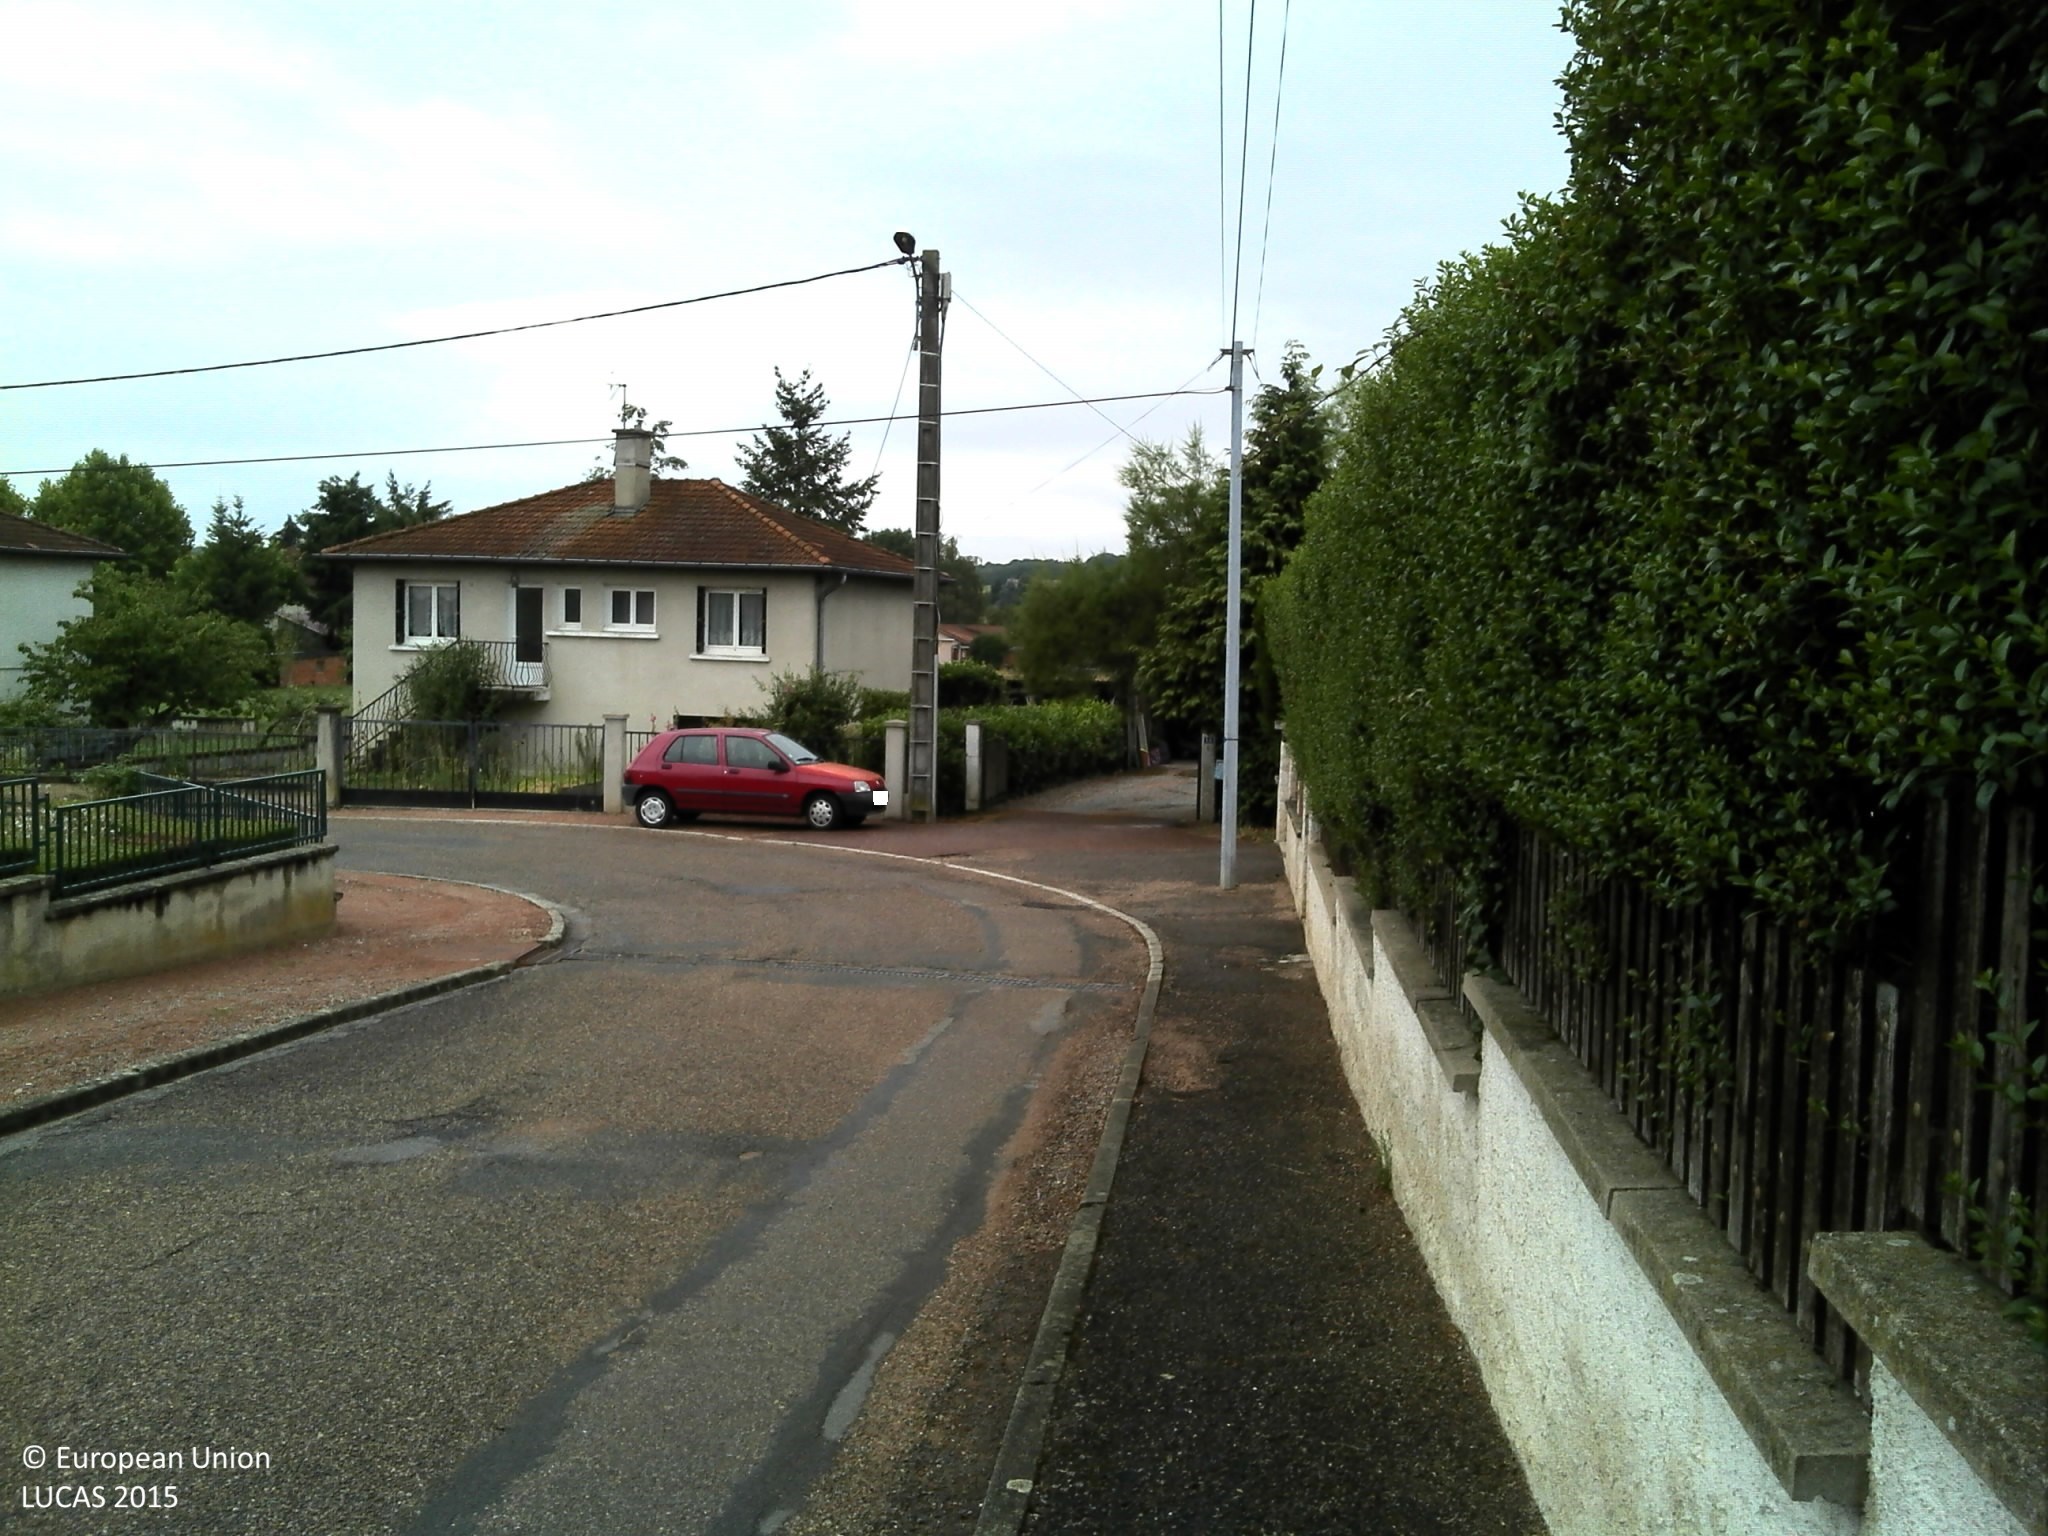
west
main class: Grassland
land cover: Grassland without tree/shrub cover
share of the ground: > 75 %
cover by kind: herbaceous plants 100 %
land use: Residential
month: August
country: FR
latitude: 46.1514
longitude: 4.0842
